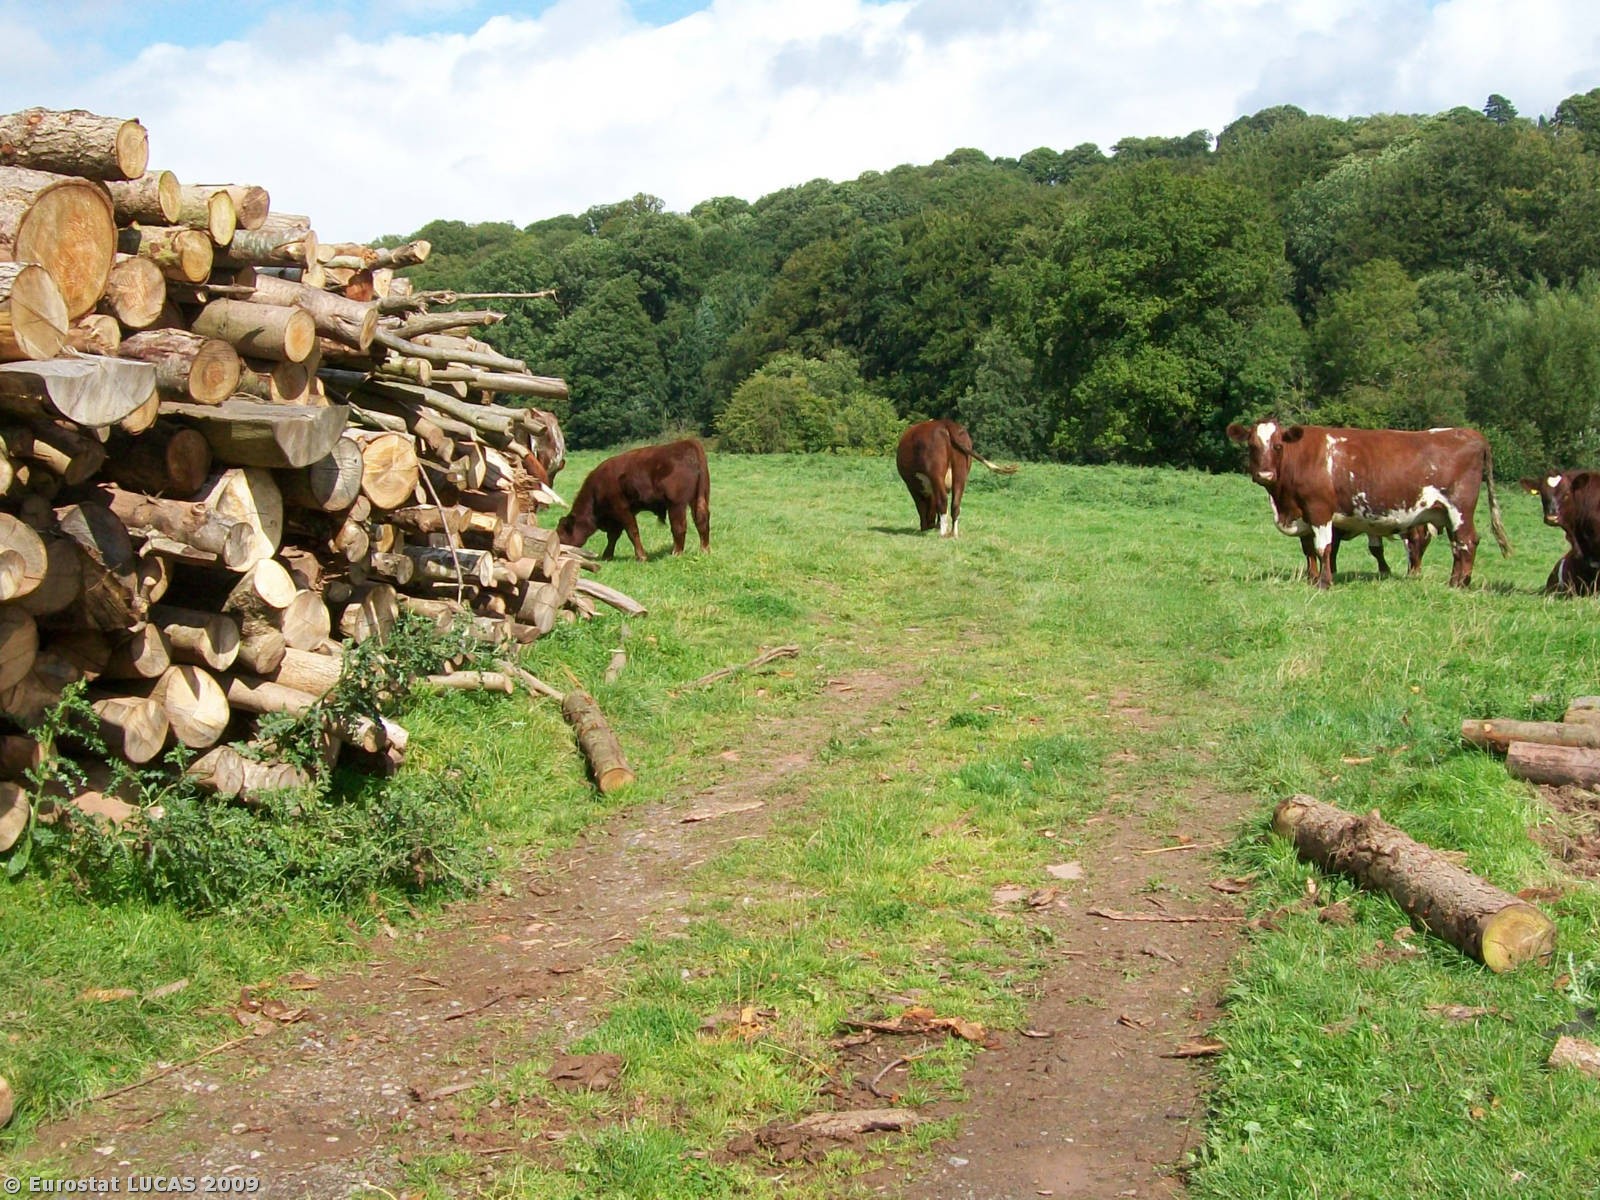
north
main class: Grassland
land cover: Grassland without tree/shrub cover
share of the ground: > 75 %
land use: Agriculture (excluding fallow land and kitchen gardens)
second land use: Community services
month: September
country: GB
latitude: 52.2122
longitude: -2.4320
